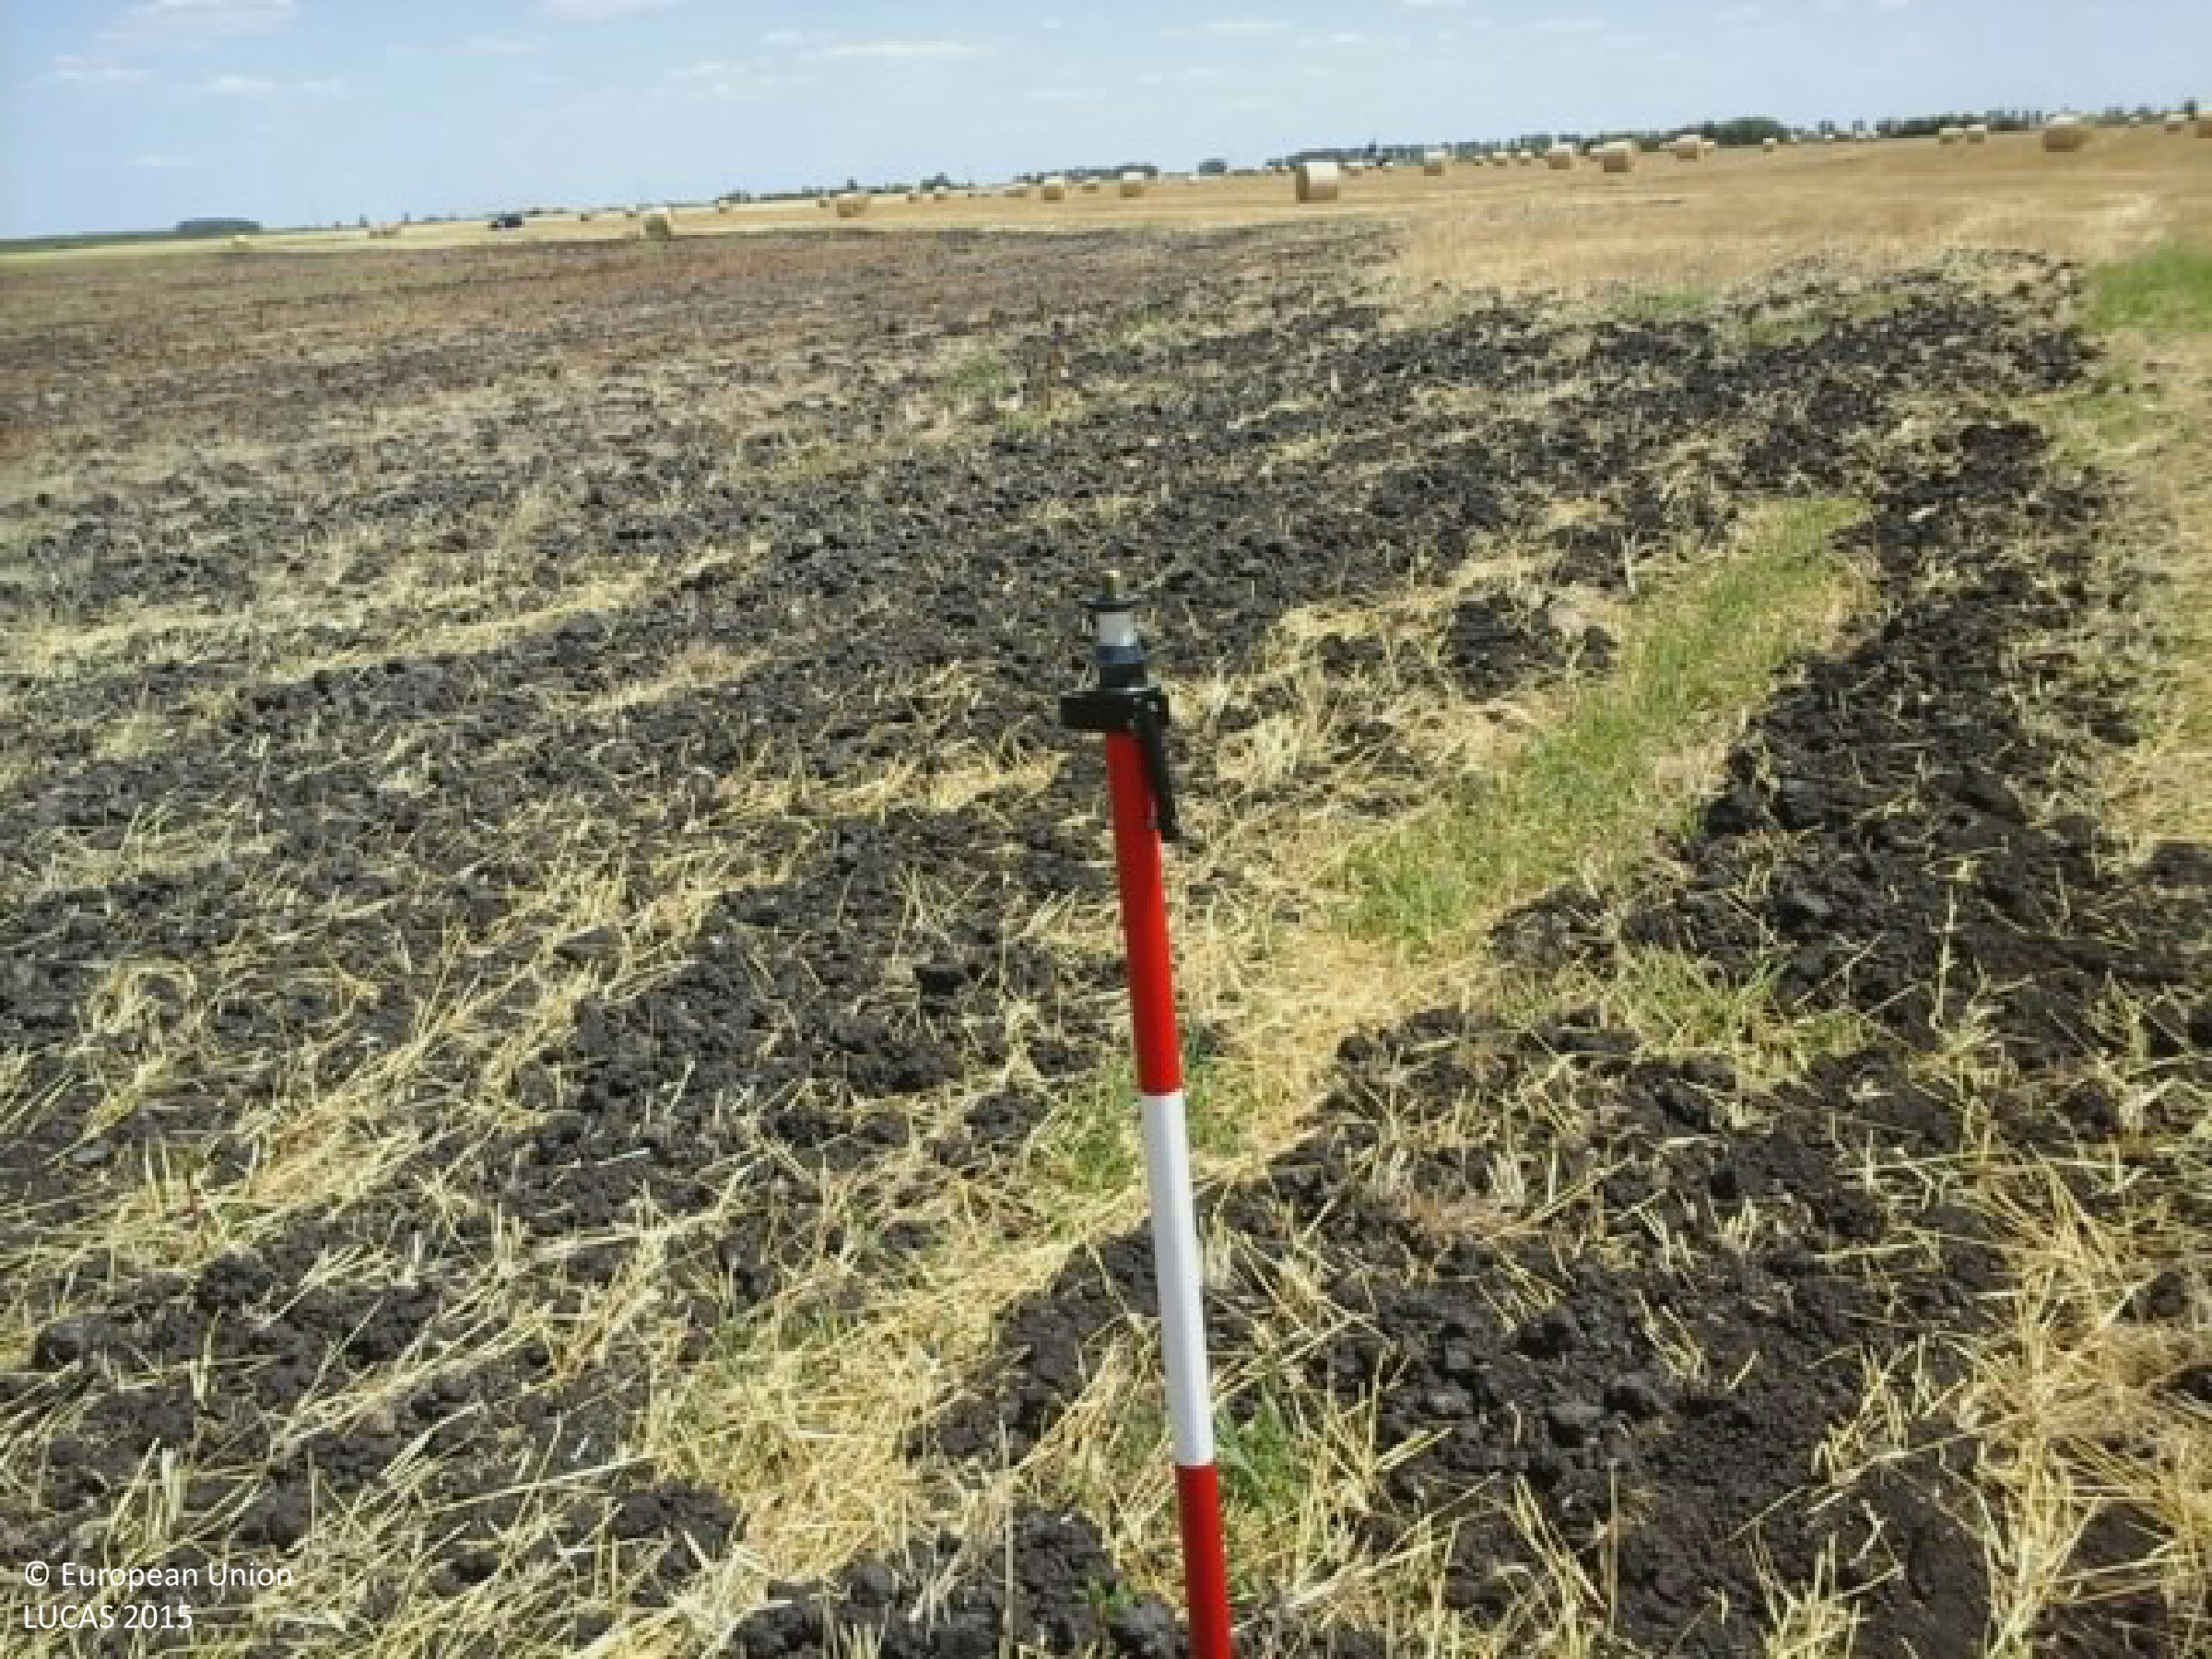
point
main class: Cropland
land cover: Common wheat
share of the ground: < 10 %
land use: Agriculture (excluding fallow land and kitchen gardens)
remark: Harvested field
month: July
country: HU
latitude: 47.6168
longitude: 20.4485
